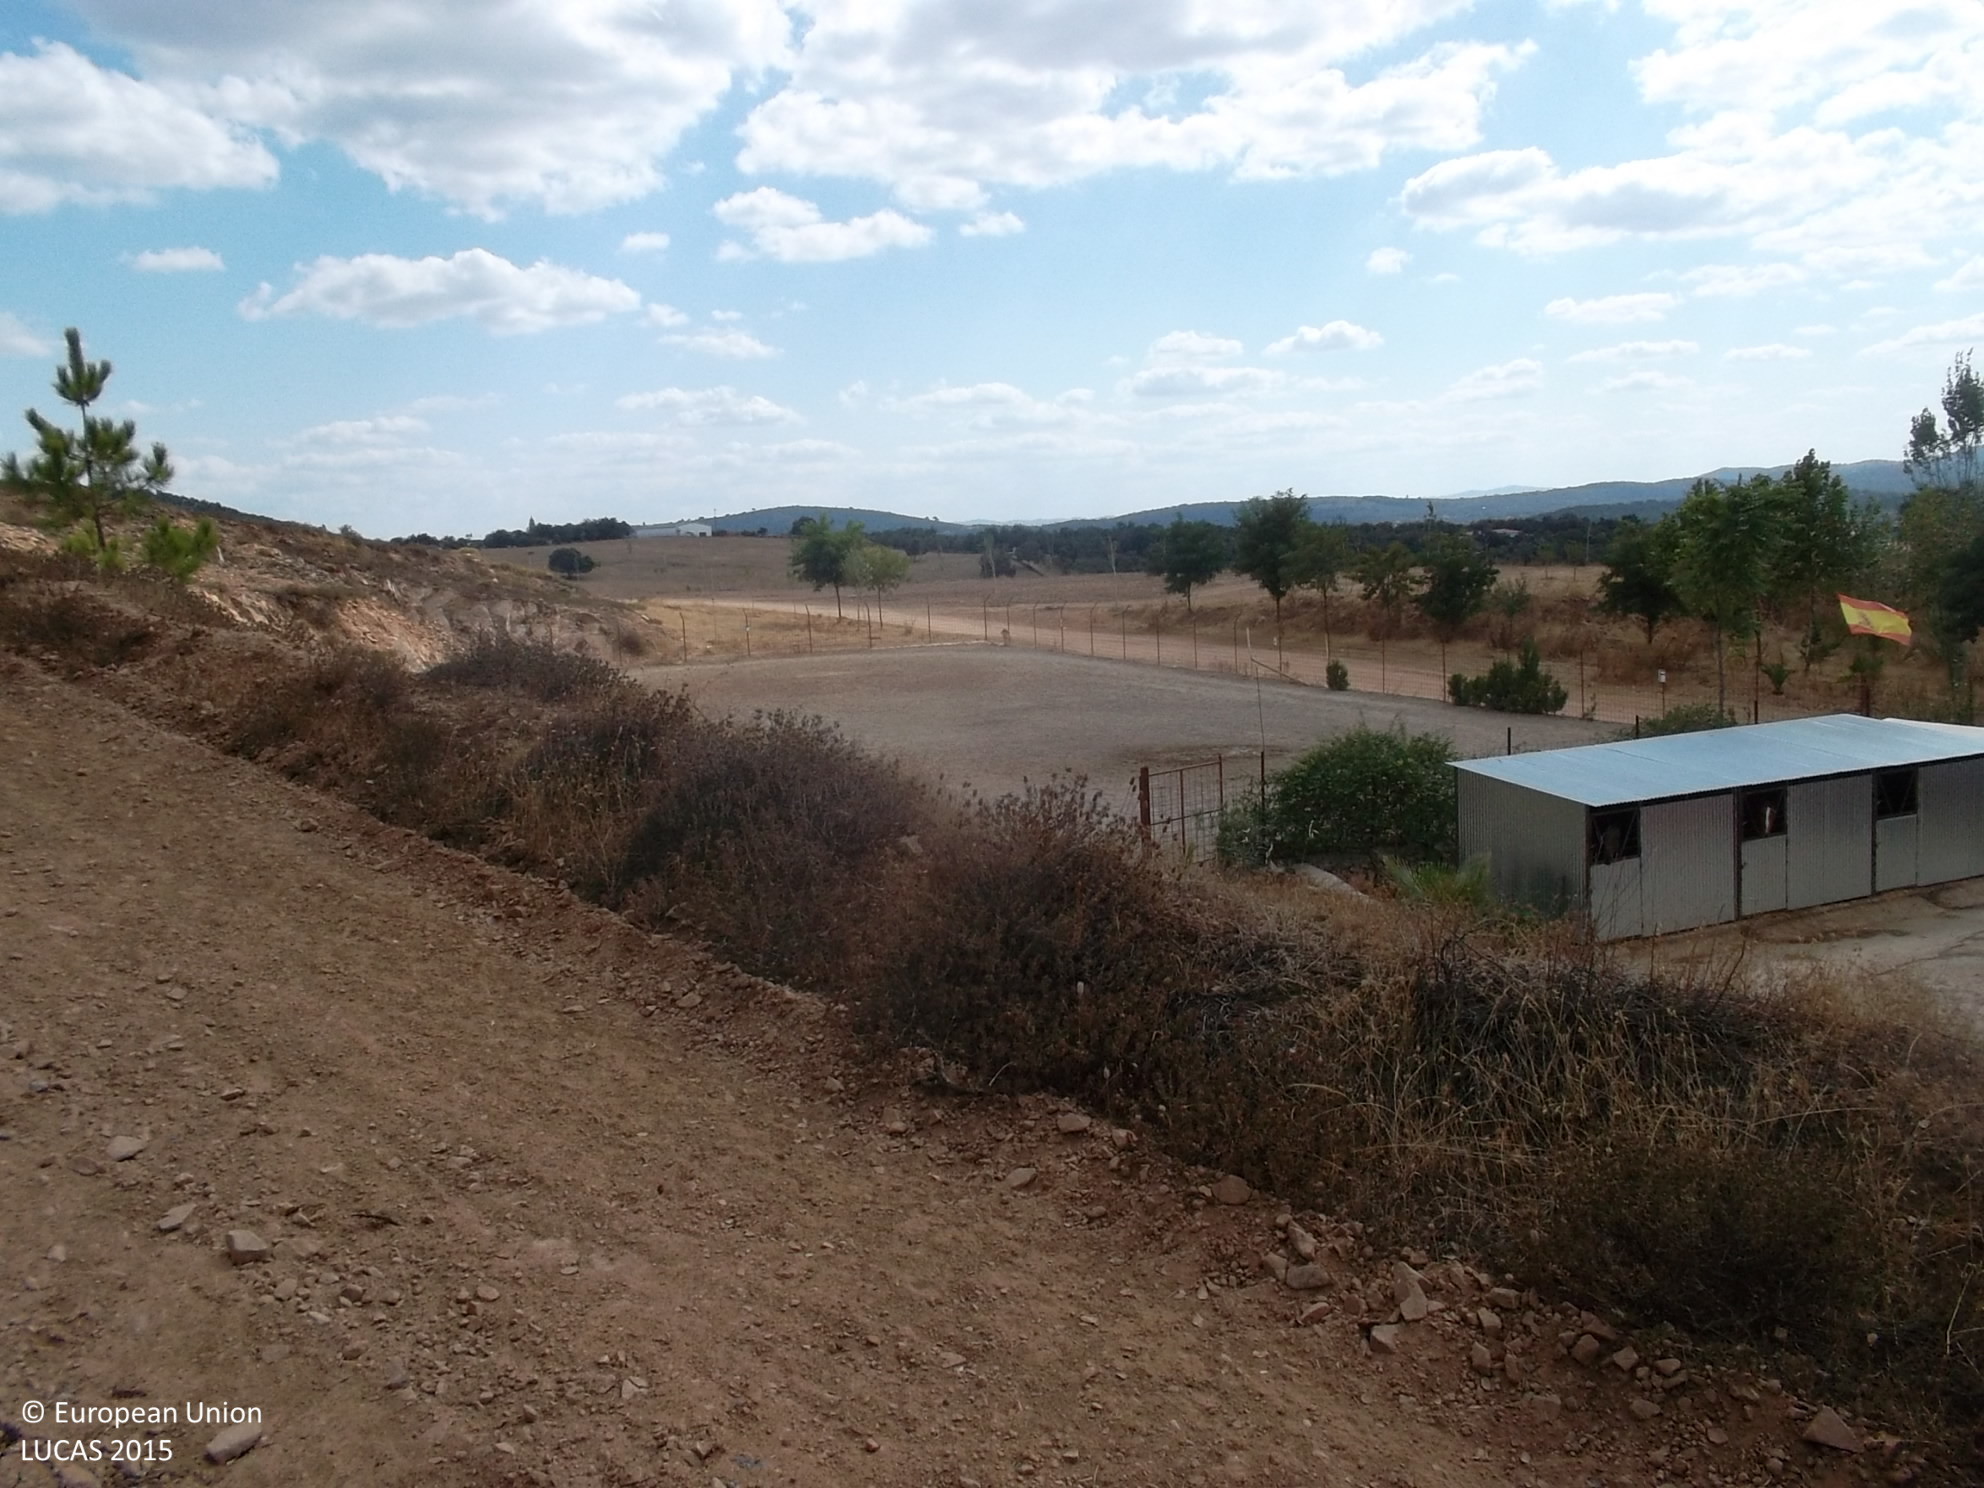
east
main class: Woodland
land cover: Broadleaved woodland
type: broadleaved evergreen forest
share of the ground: > 75 %
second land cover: Grassland without tree/shrub cover
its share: > 75 %
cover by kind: broadleaved forest trees 80 %, herbaceous plants 20 %
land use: Forestry
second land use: Agriculture (excluding fallow land and kitchen gardens)
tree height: > 5 m
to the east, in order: Broadleaved woodland; Grassland without tree/shrub cover; Dry stone walls; Broadleaved woodland; Dry stone walls; Other bare soil; Dry stone walls; Abandoned hedges; Olive groves; Broadleaved woodland; Olive groves
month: September
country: ES
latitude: 38.0778
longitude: -6.5423
